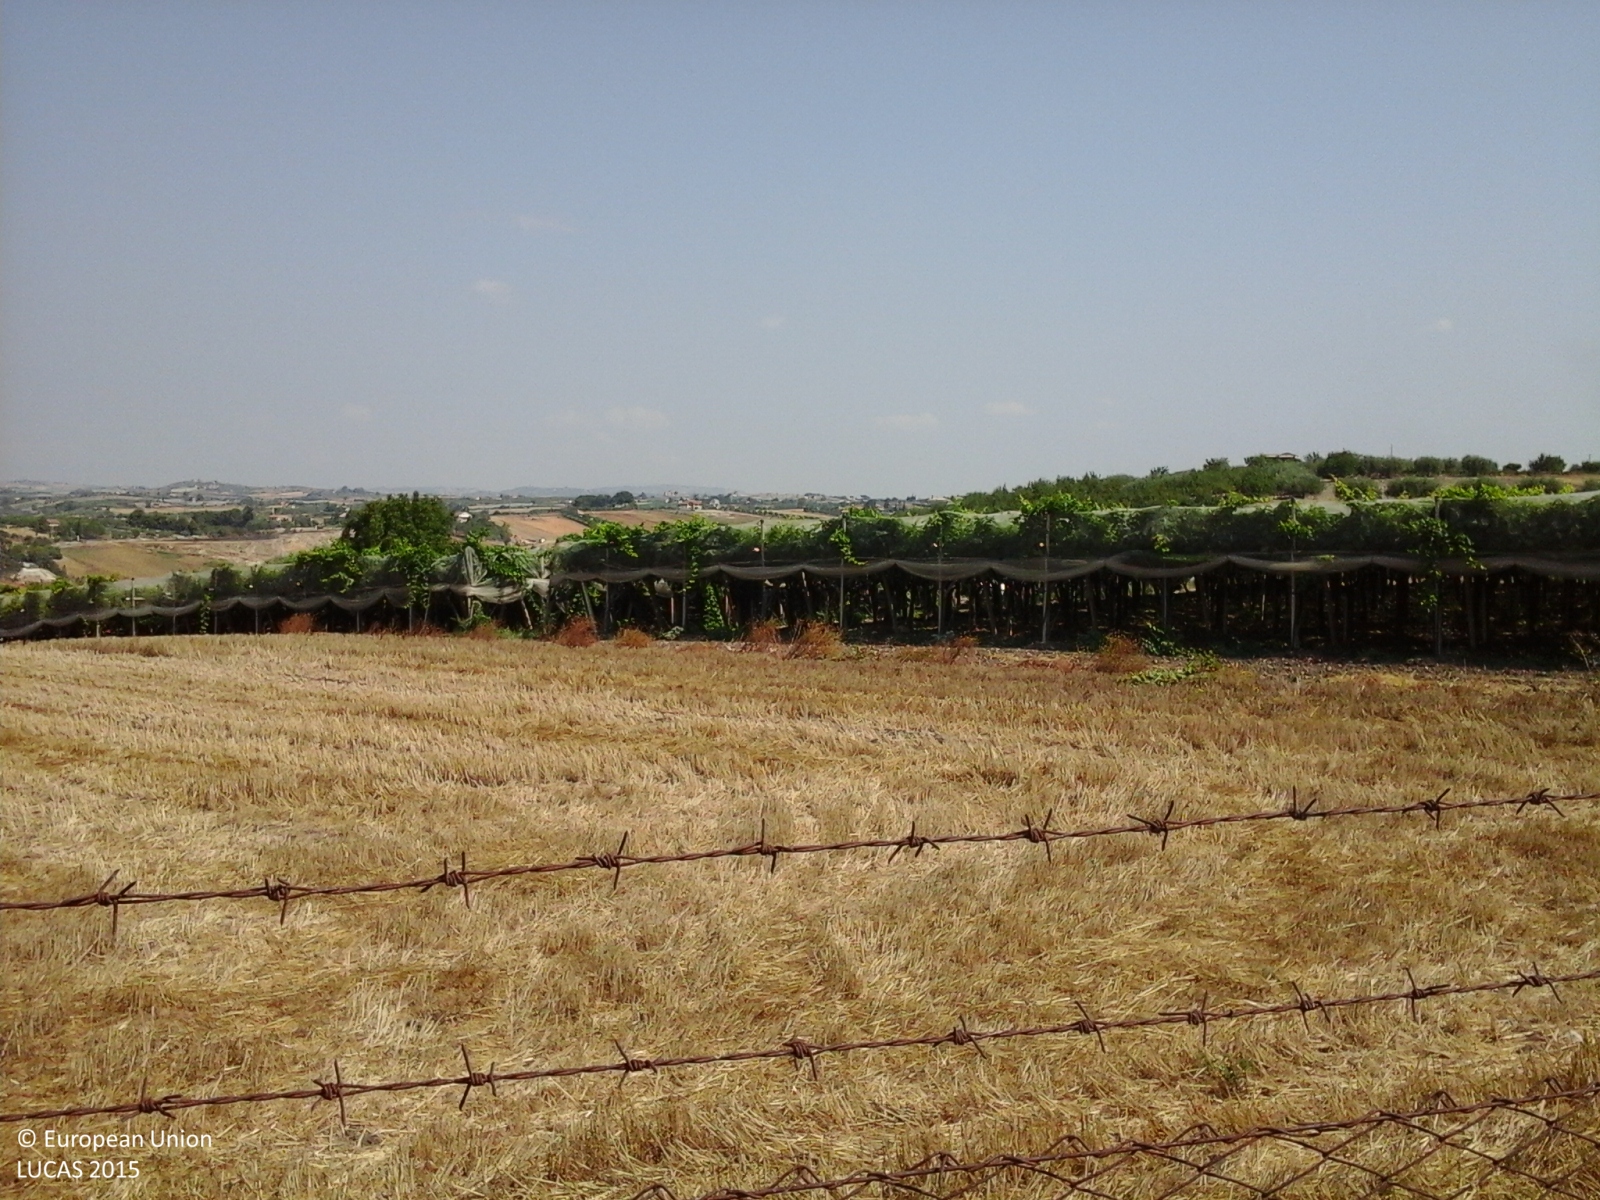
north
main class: Cropland
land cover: Vineyards
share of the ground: > 75 %
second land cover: Other bare soil
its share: > 75 %
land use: Agriculture (excluding fallow land and kitchen gardens)
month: July
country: IT
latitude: 37.2493
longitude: 13.9042
